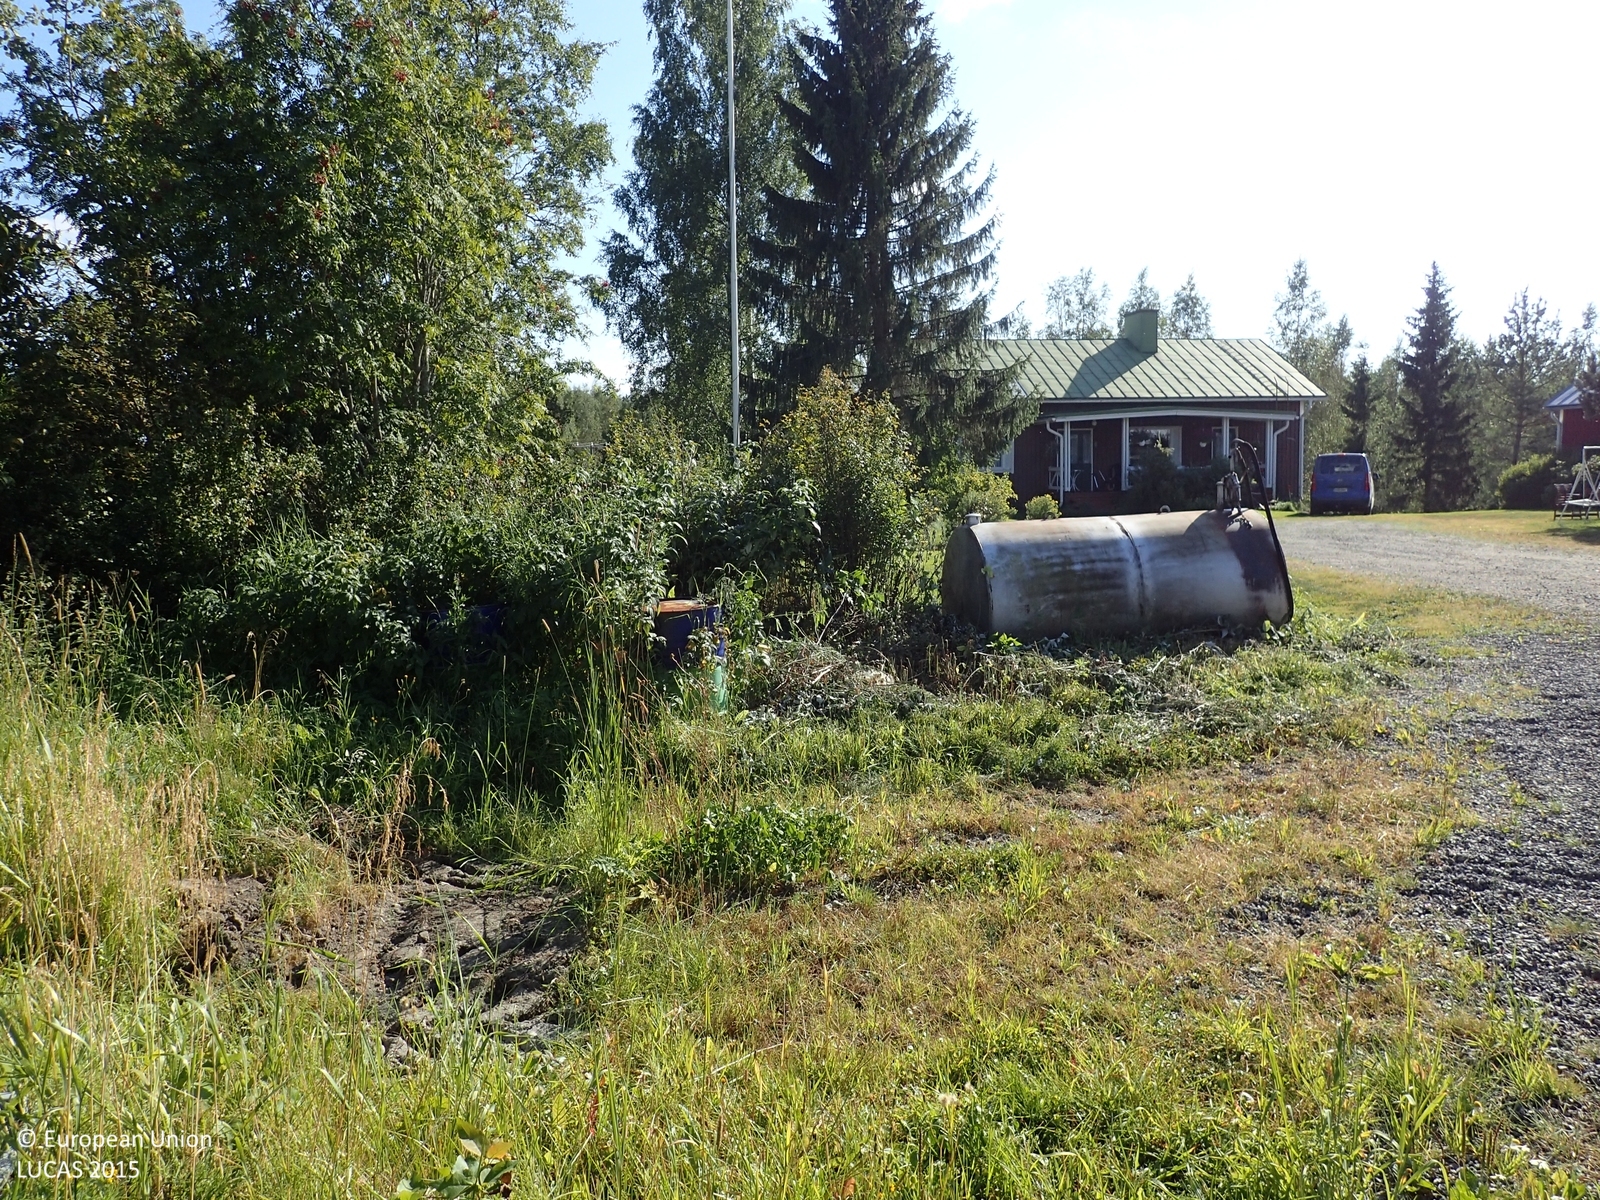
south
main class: Woodland
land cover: Broadleaved woodland
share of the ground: 25 - 50 %
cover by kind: herbaceous plants 60 %, broadleaved forest trees 40 %
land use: Residential
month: August
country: FI
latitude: 62.5123
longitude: 21.7961
